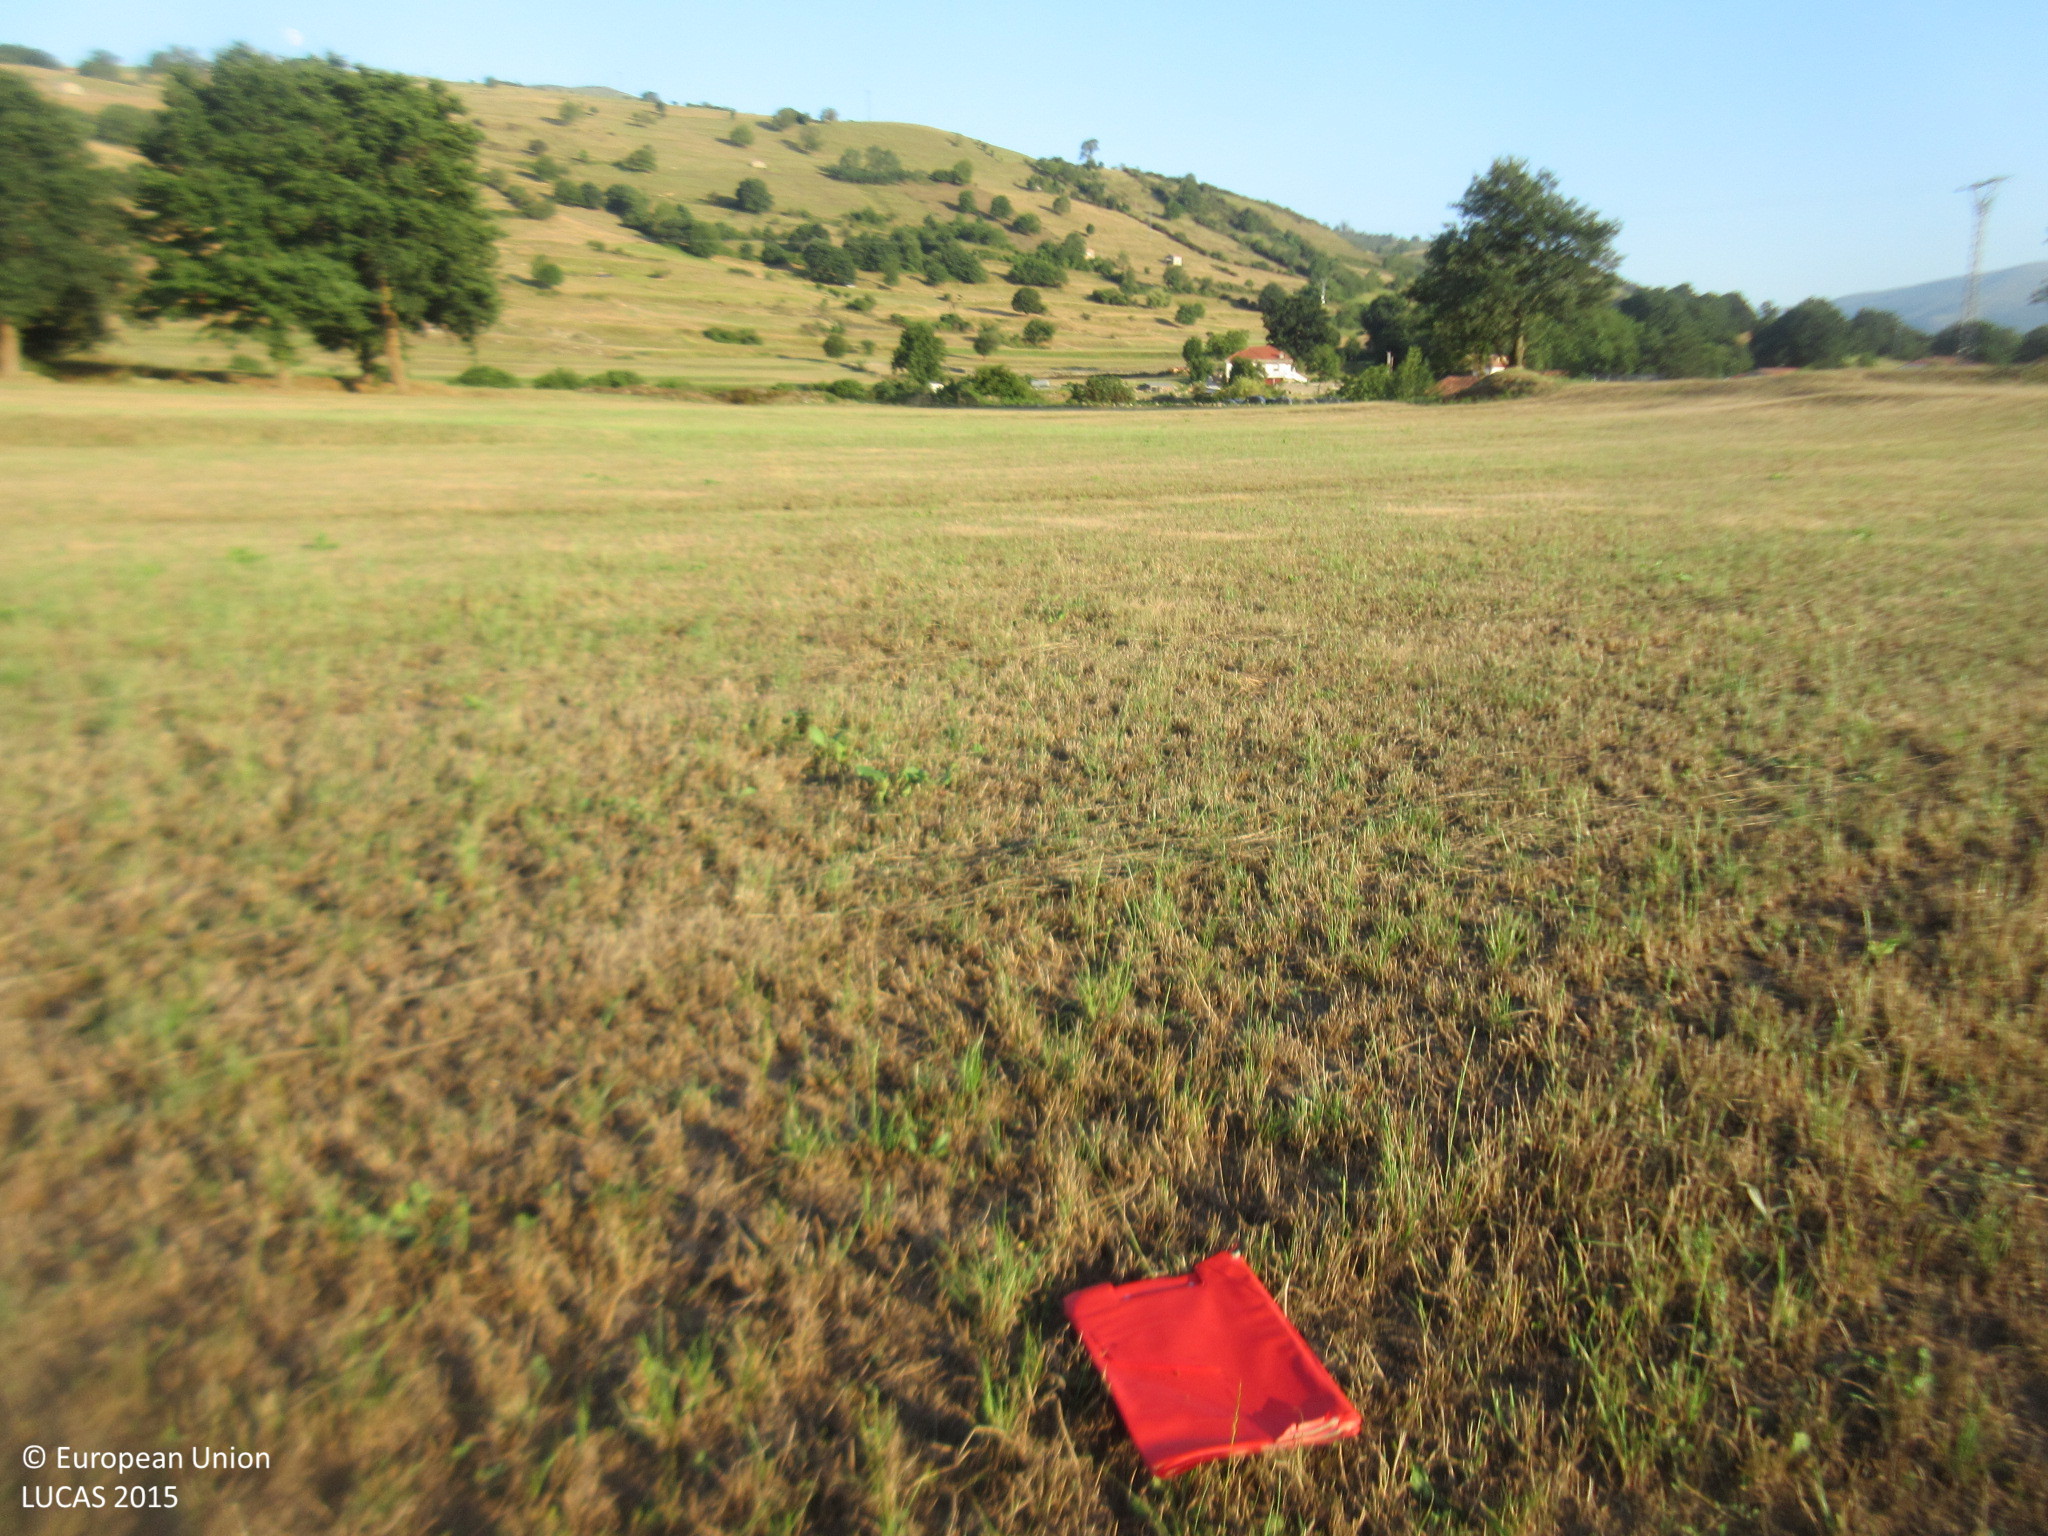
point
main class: Cropland
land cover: Temporary grasslands
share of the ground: > 75 %
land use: Agriculture (excluding fallow land and kitchen gardens)
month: July
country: ES
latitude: 43.2591
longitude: -3.9324
